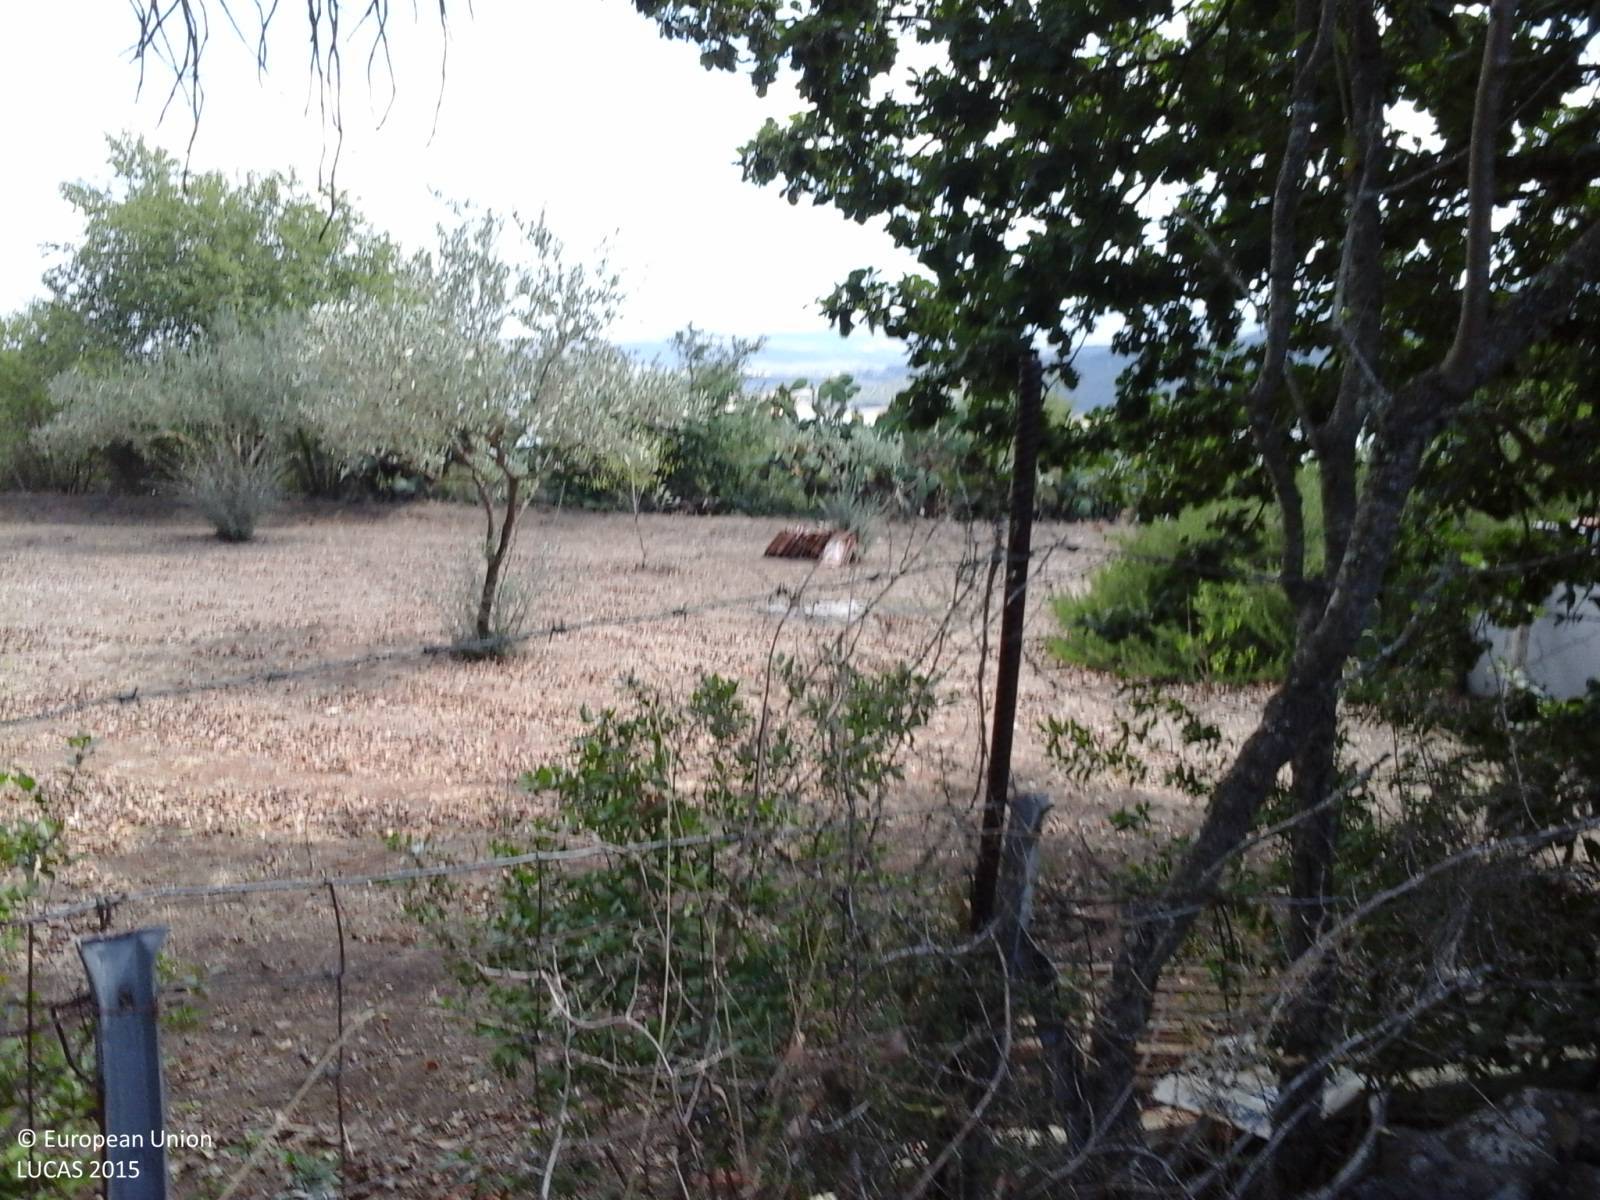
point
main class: Cropland
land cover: Olive groves
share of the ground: > 75 %
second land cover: Grassland without tree/shrub cover
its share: > 75 %
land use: Agriculture (excluding fallow land and kitchen gardens)
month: August
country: IT
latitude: 40.1162
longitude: 8.8913
